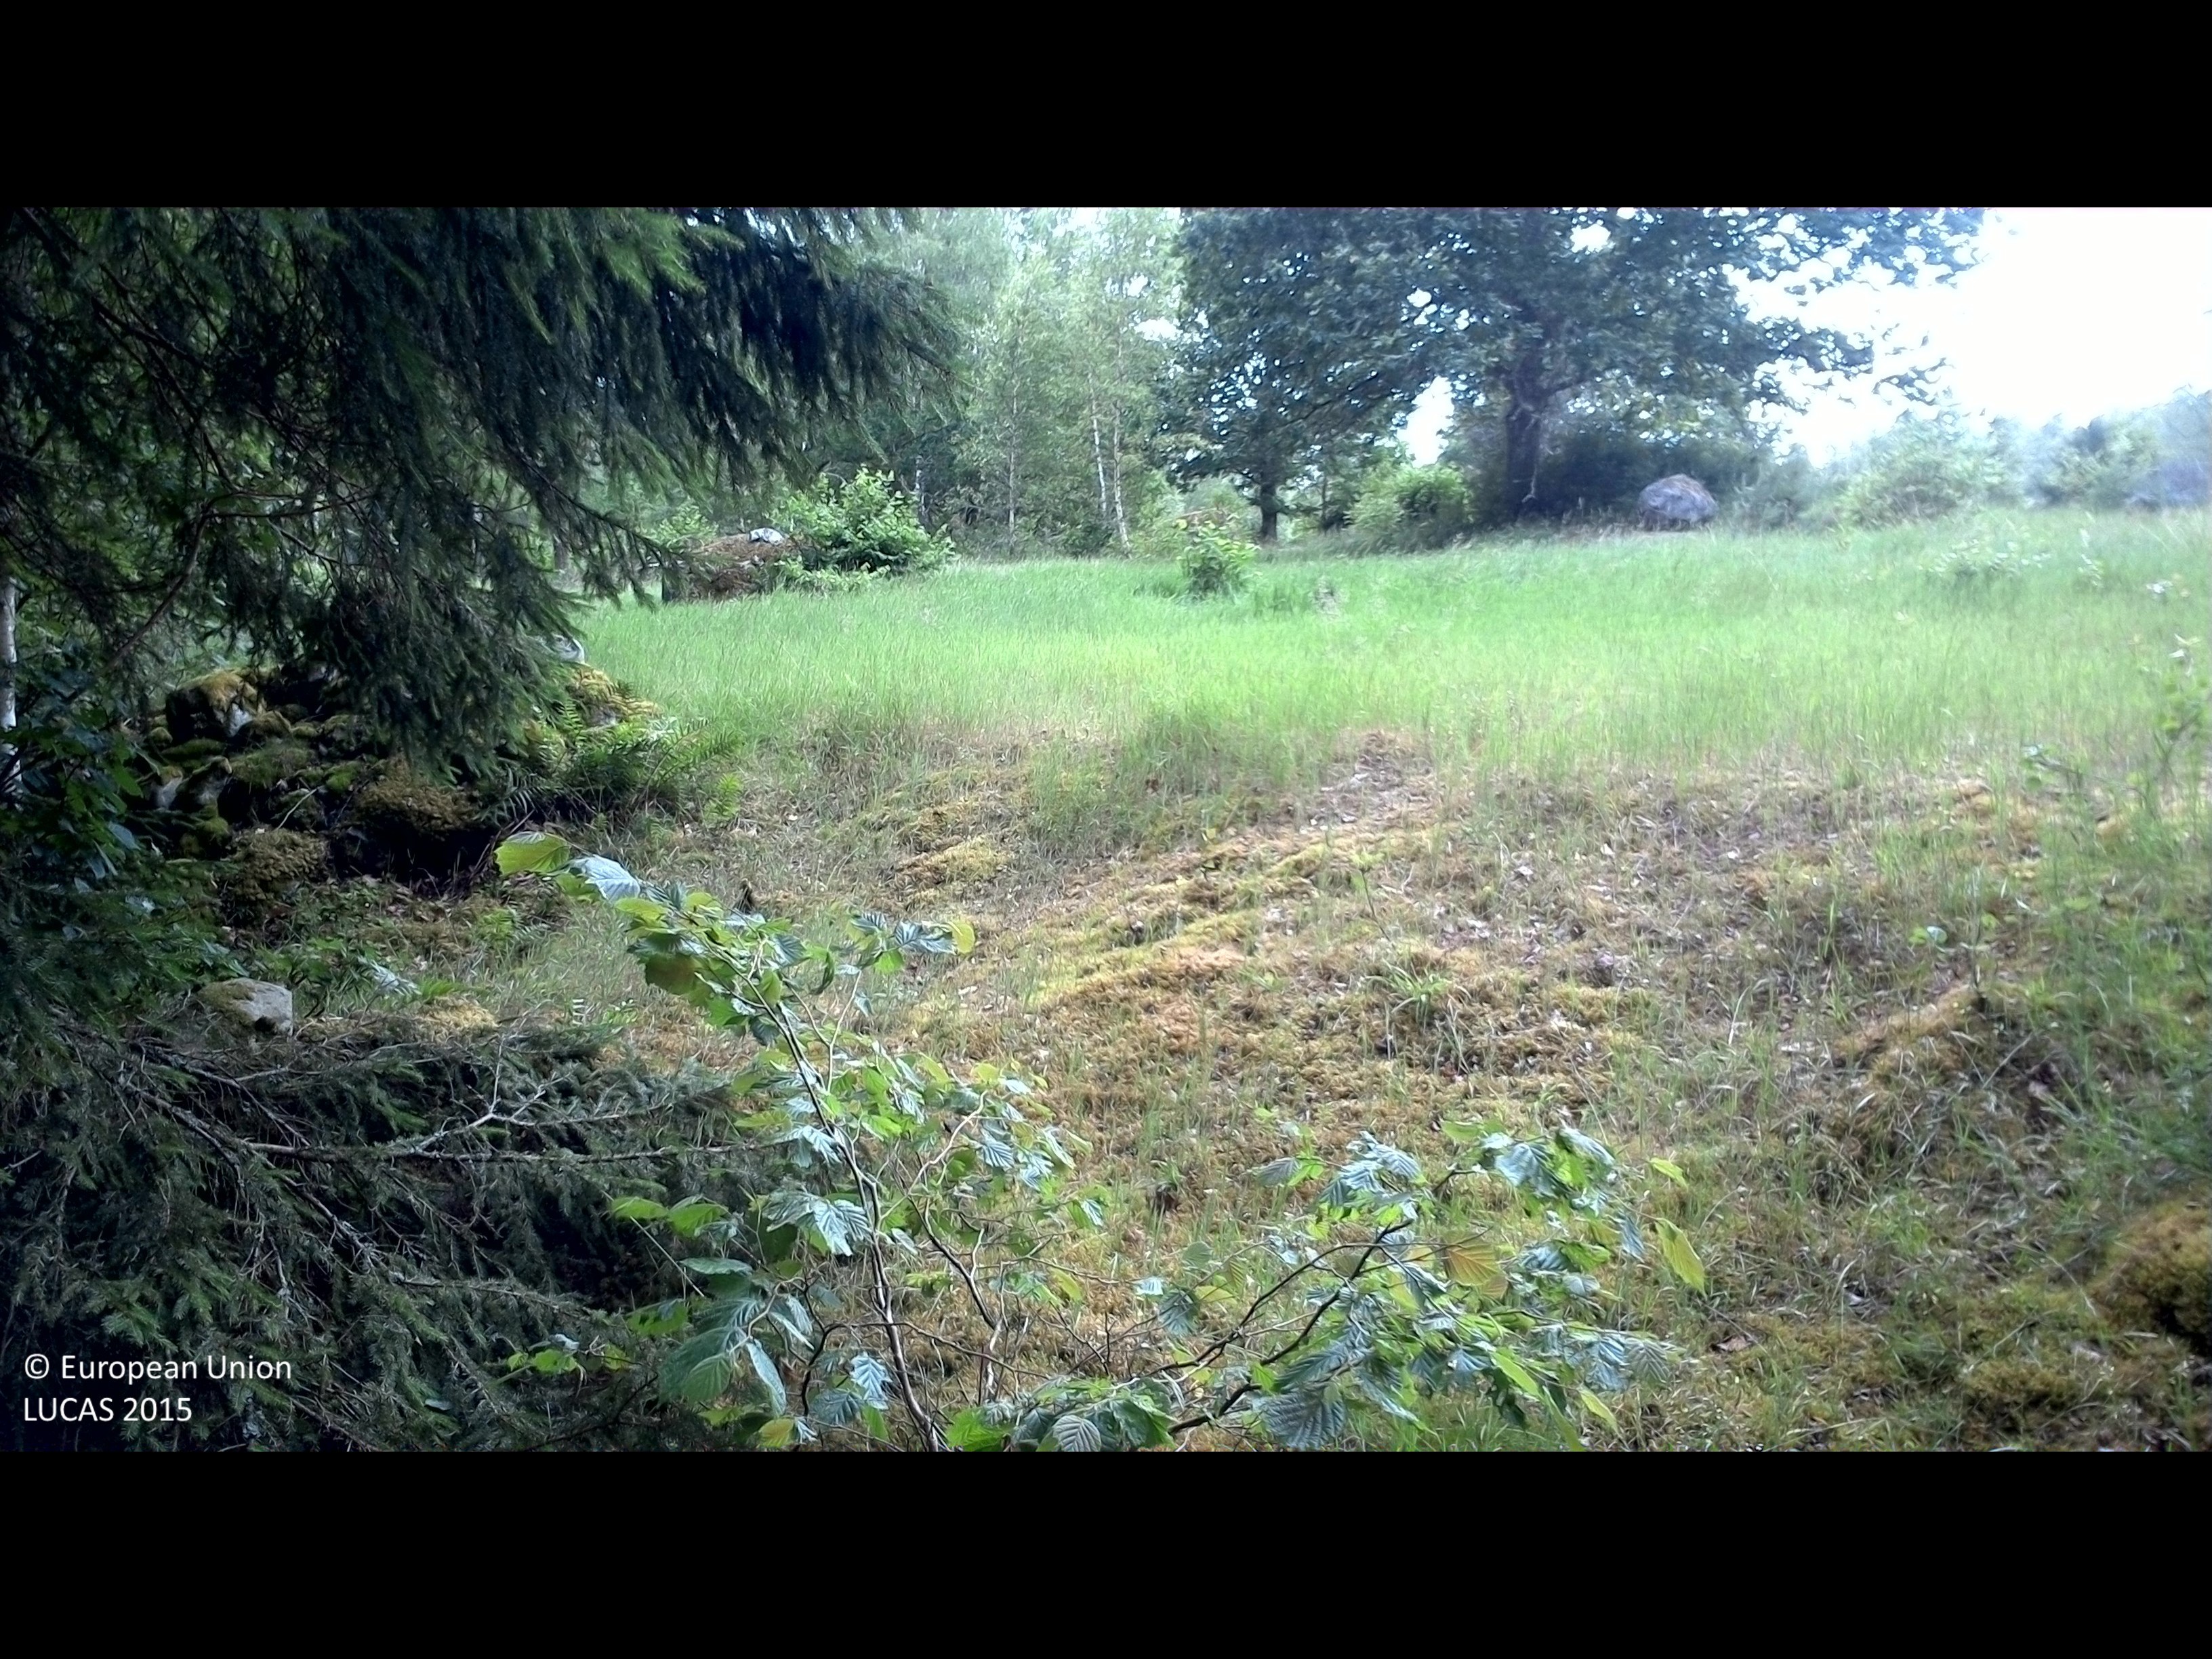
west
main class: Woodland
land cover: Spruce dominated mixed woodland
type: boreal forest
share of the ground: > 75 %
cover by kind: coniferous forest trees 55 %, broadleaved forest trees 20 %, shrubs 15 %, herbaceous plants 10 %
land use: Forestry
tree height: > 5 m
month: July
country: SE
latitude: 56.4600
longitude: 14.7527
